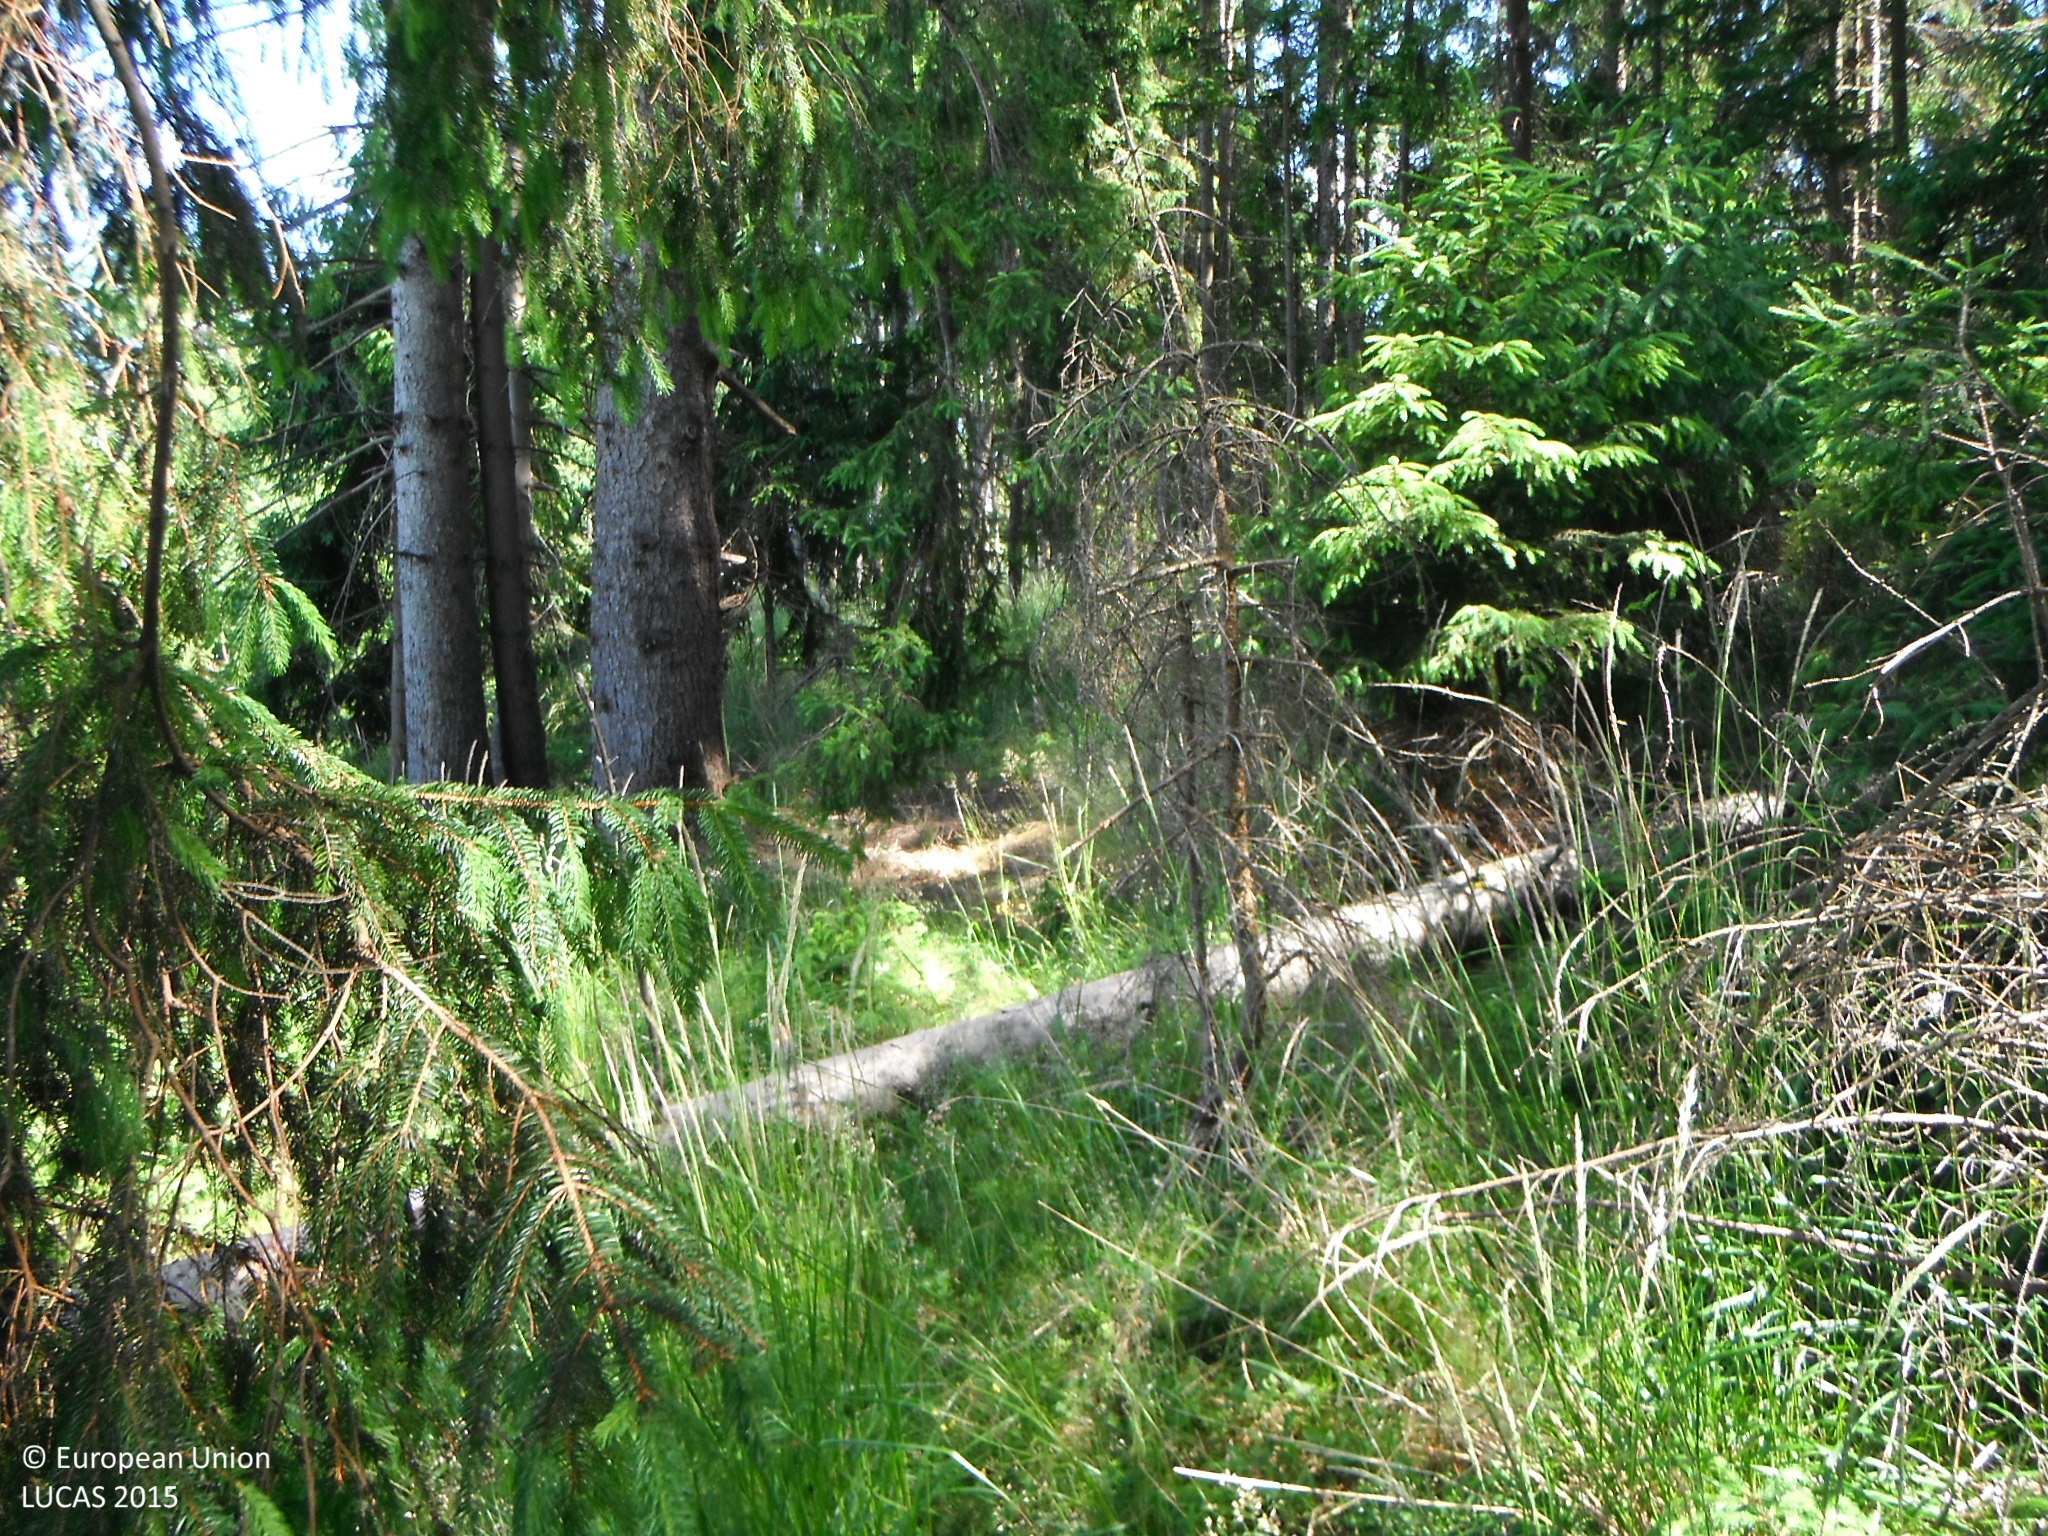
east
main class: Woodland
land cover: Spruce dominated coniferous woodland
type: alpine coniferous forest
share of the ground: > 75 %
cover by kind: coniferous forest trees 85 %, herbaceous plants 15 %
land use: Forestry
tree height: > 5 m
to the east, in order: Spruce dominated coniferous woodland; Grassland without tree/shrub cover; Spruce dominated coniferous woodland; Grassland without tree/shrub cover
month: July
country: SK
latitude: 48.9762
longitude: 20.2665
